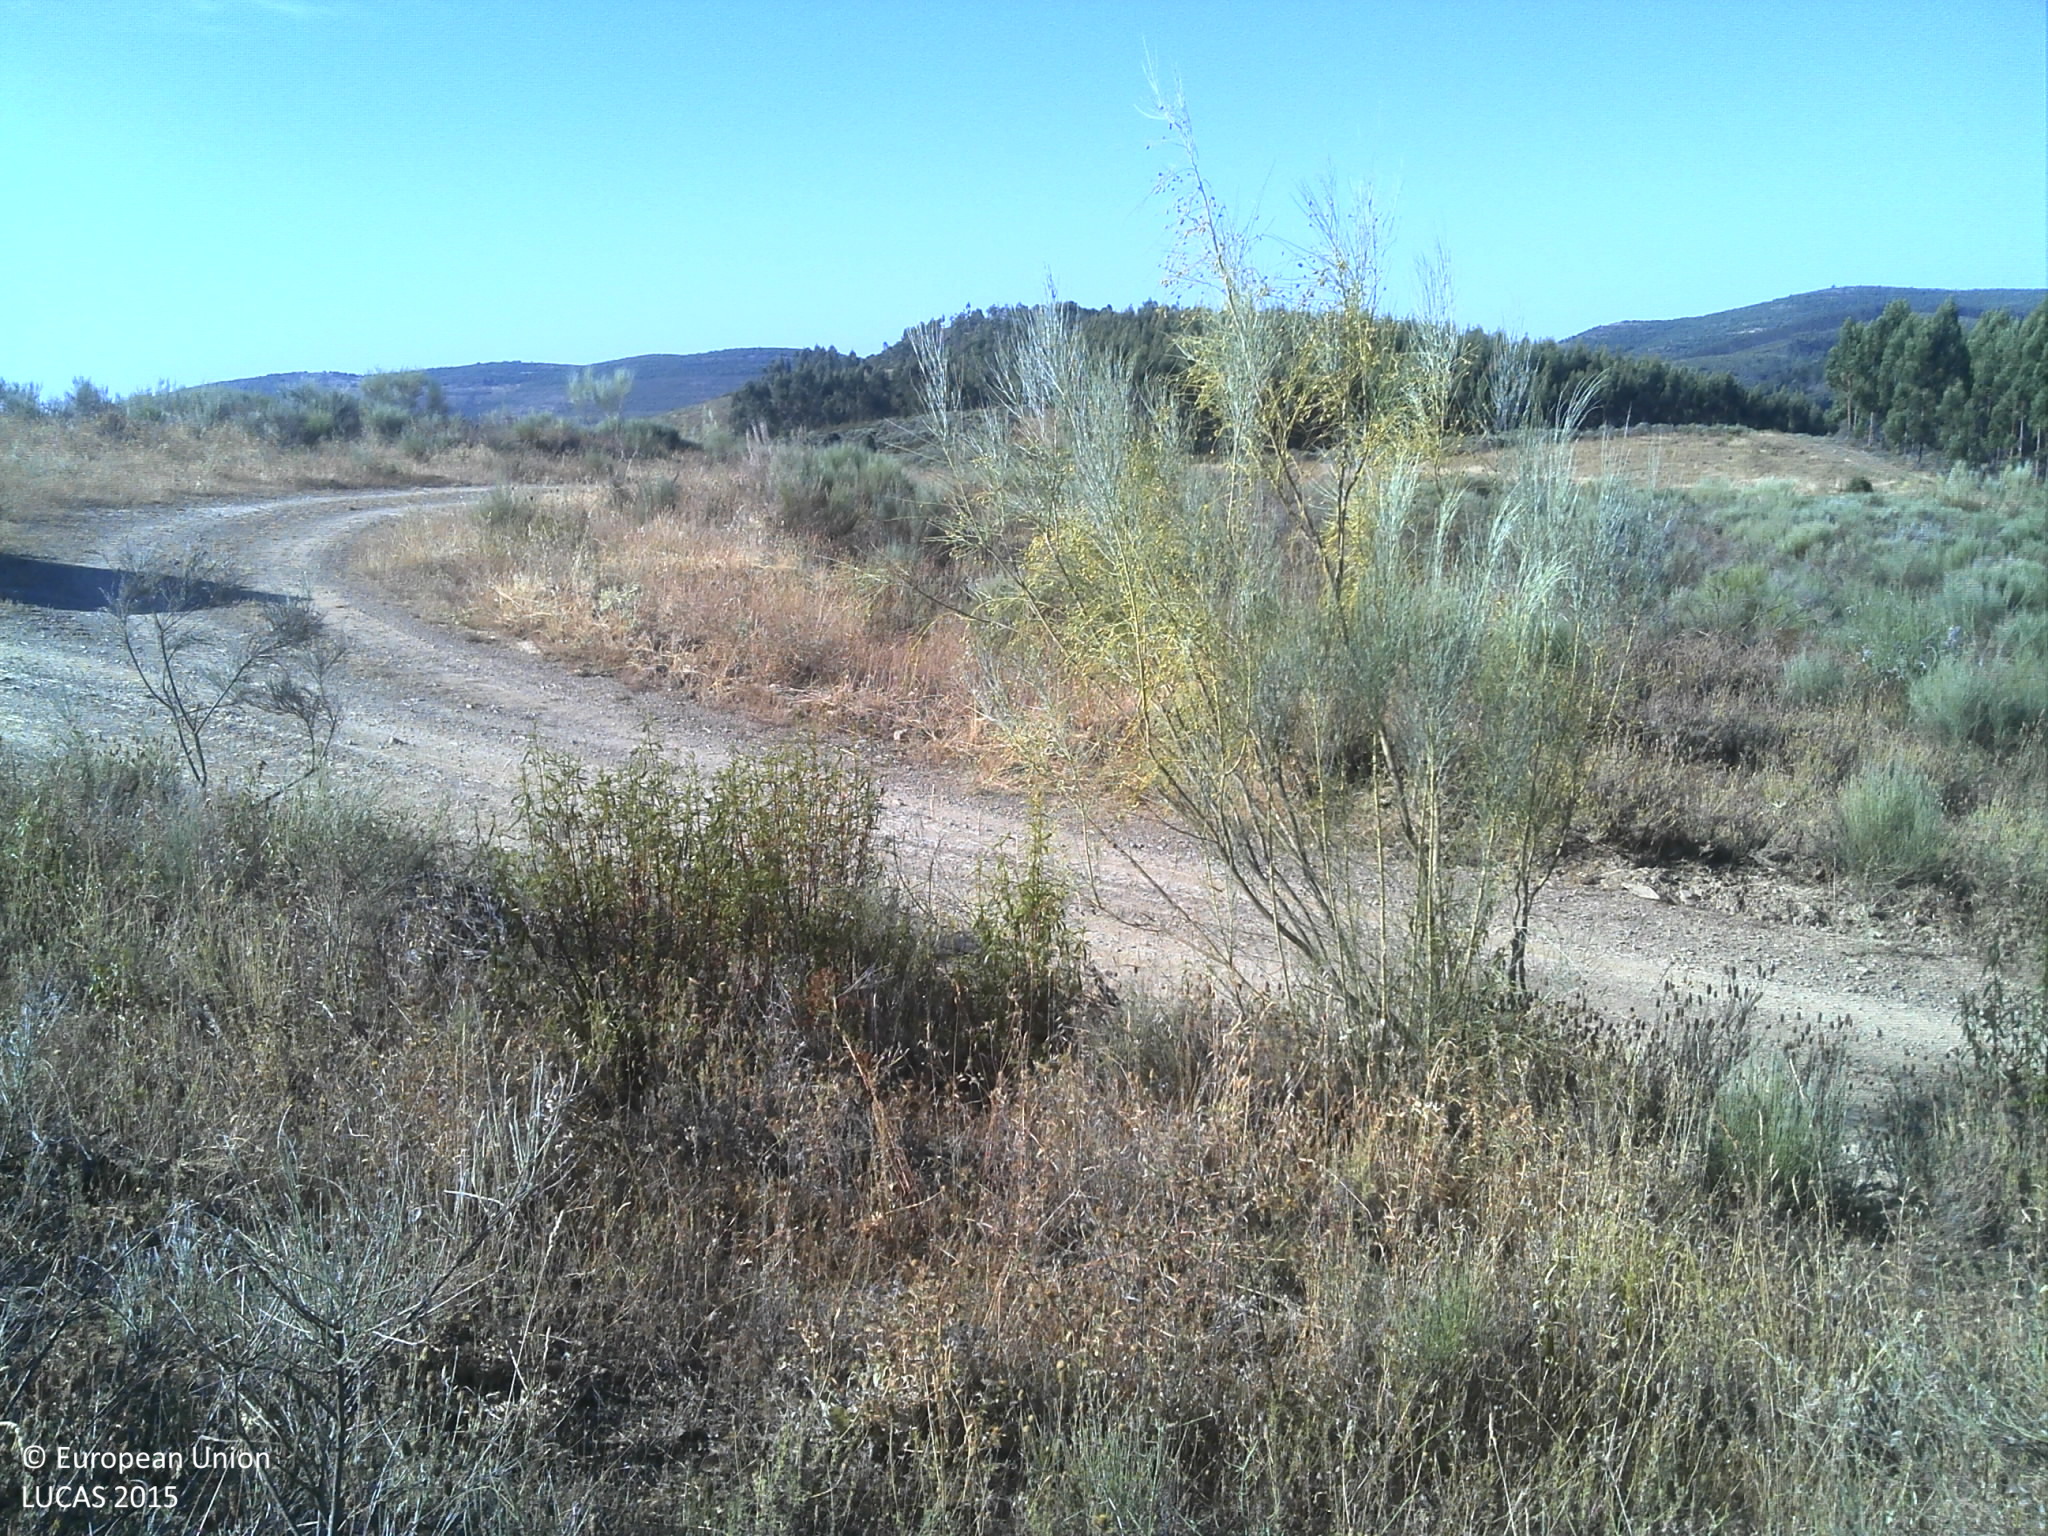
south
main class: Shrubland
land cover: Shrubland without tree cover
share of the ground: > 75 %
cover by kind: shrubs 100 %
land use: Semi-natural and natural areas not in use
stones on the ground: 25 - 50 %
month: July
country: PT
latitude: 41.0841
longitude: -6.9506
